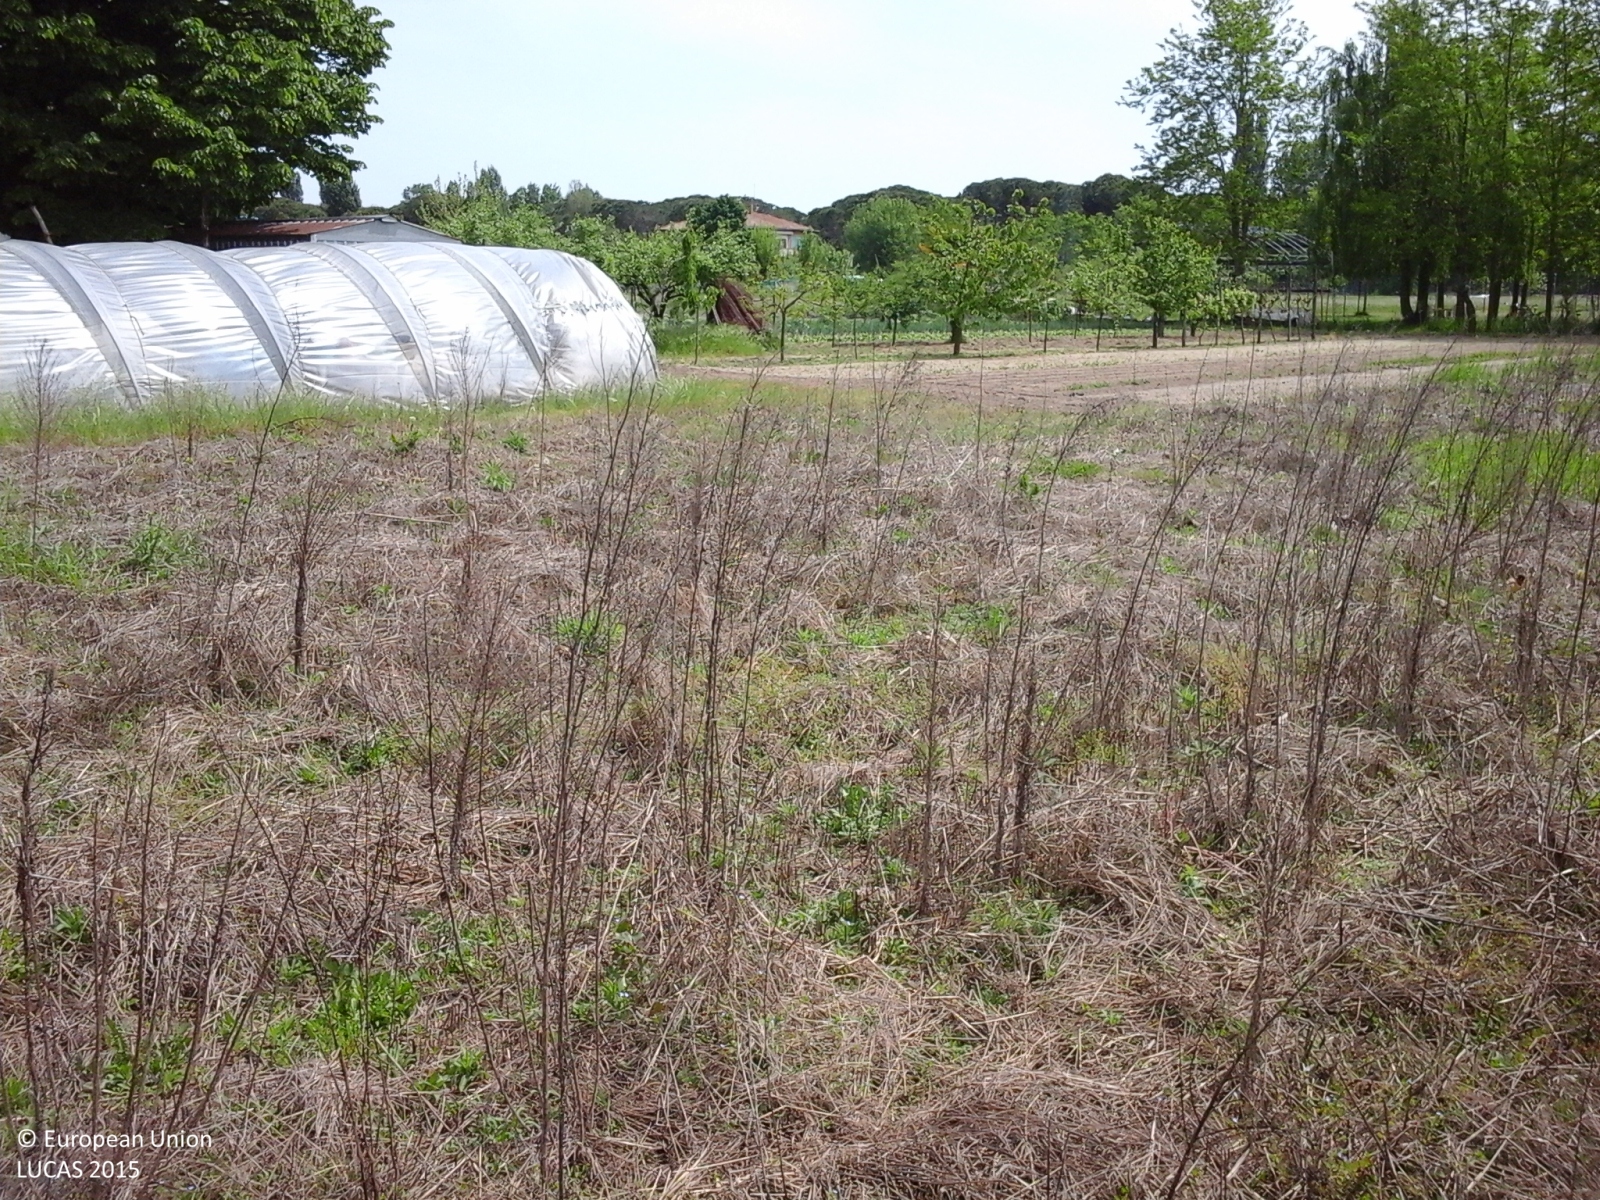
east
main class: Grassland
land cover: Spontaneously vegetated surfaces
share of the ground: 50 - 75 %
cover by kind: herbaceous plants 75 %, consolidated bare surface 25 %
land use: Fallow land
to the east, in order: Spontaneously vegetated surfaces; Other fresh vegetables; Other fruit trees and berries; Other fresh vegetables; Artificial constructions in urban areas; Ditches and canals; Spontaneously vegetated surfaces; Artificial constructions in urban areas
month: May
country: IT
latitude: 45.4402
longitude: 12.4380
